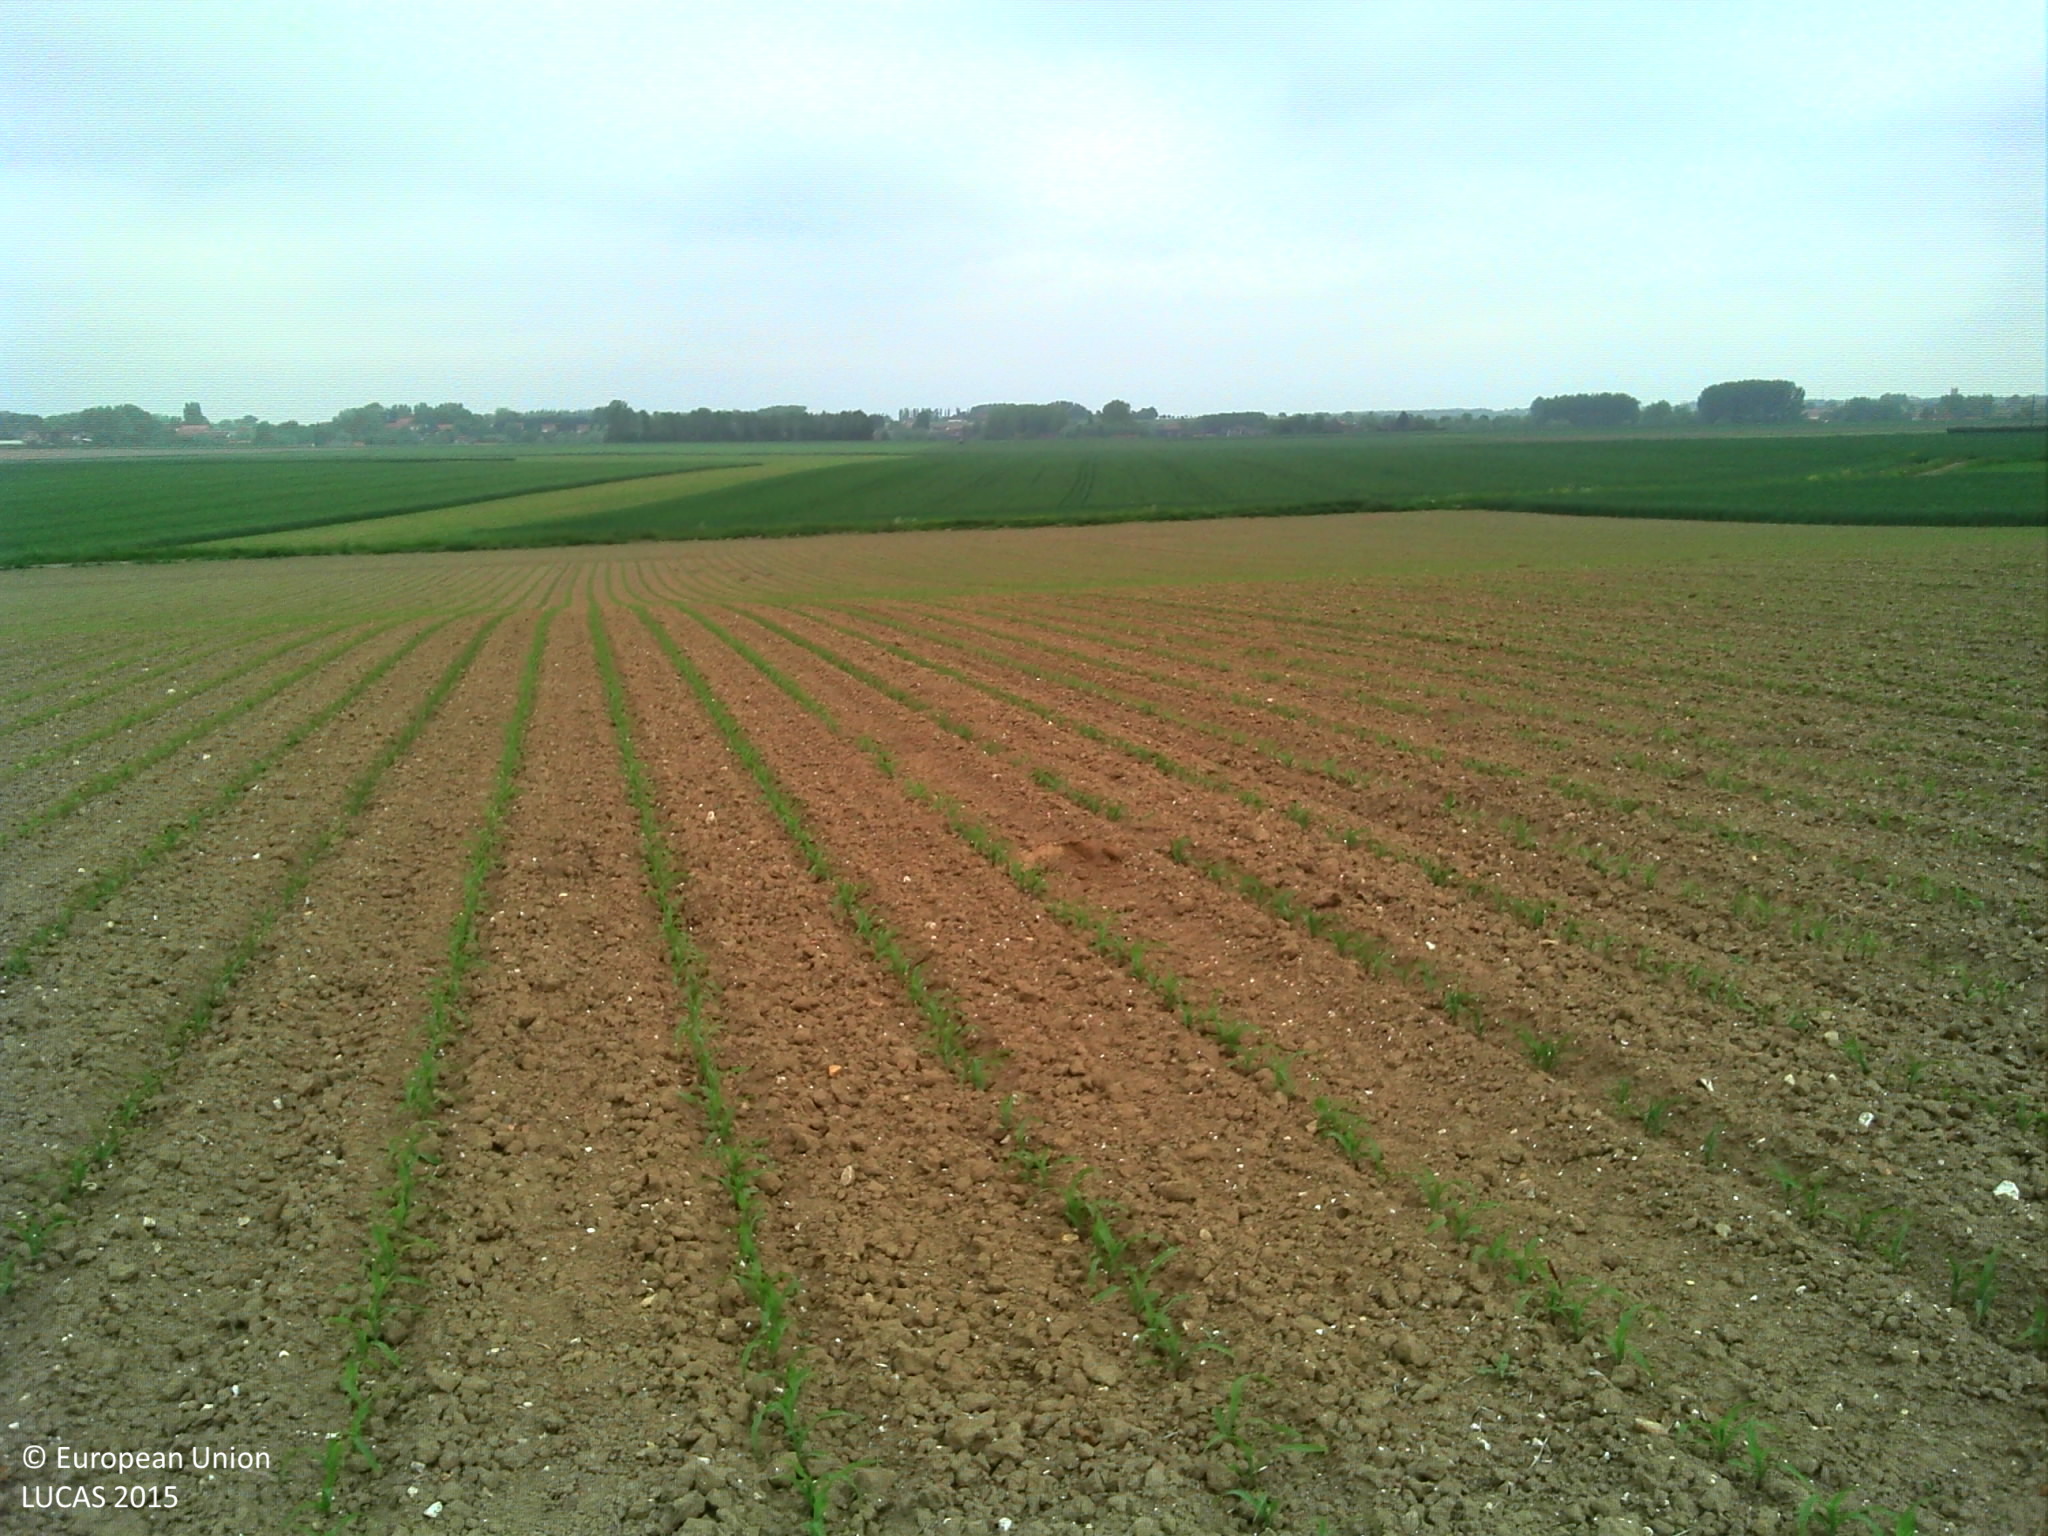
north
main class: Cropland
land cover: Maize
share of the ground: 10 - 25 %
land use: Agriculture (excluding fallow land and kitchen gardens)
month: May
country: FR
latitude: 50.6486
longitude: 2.3350
